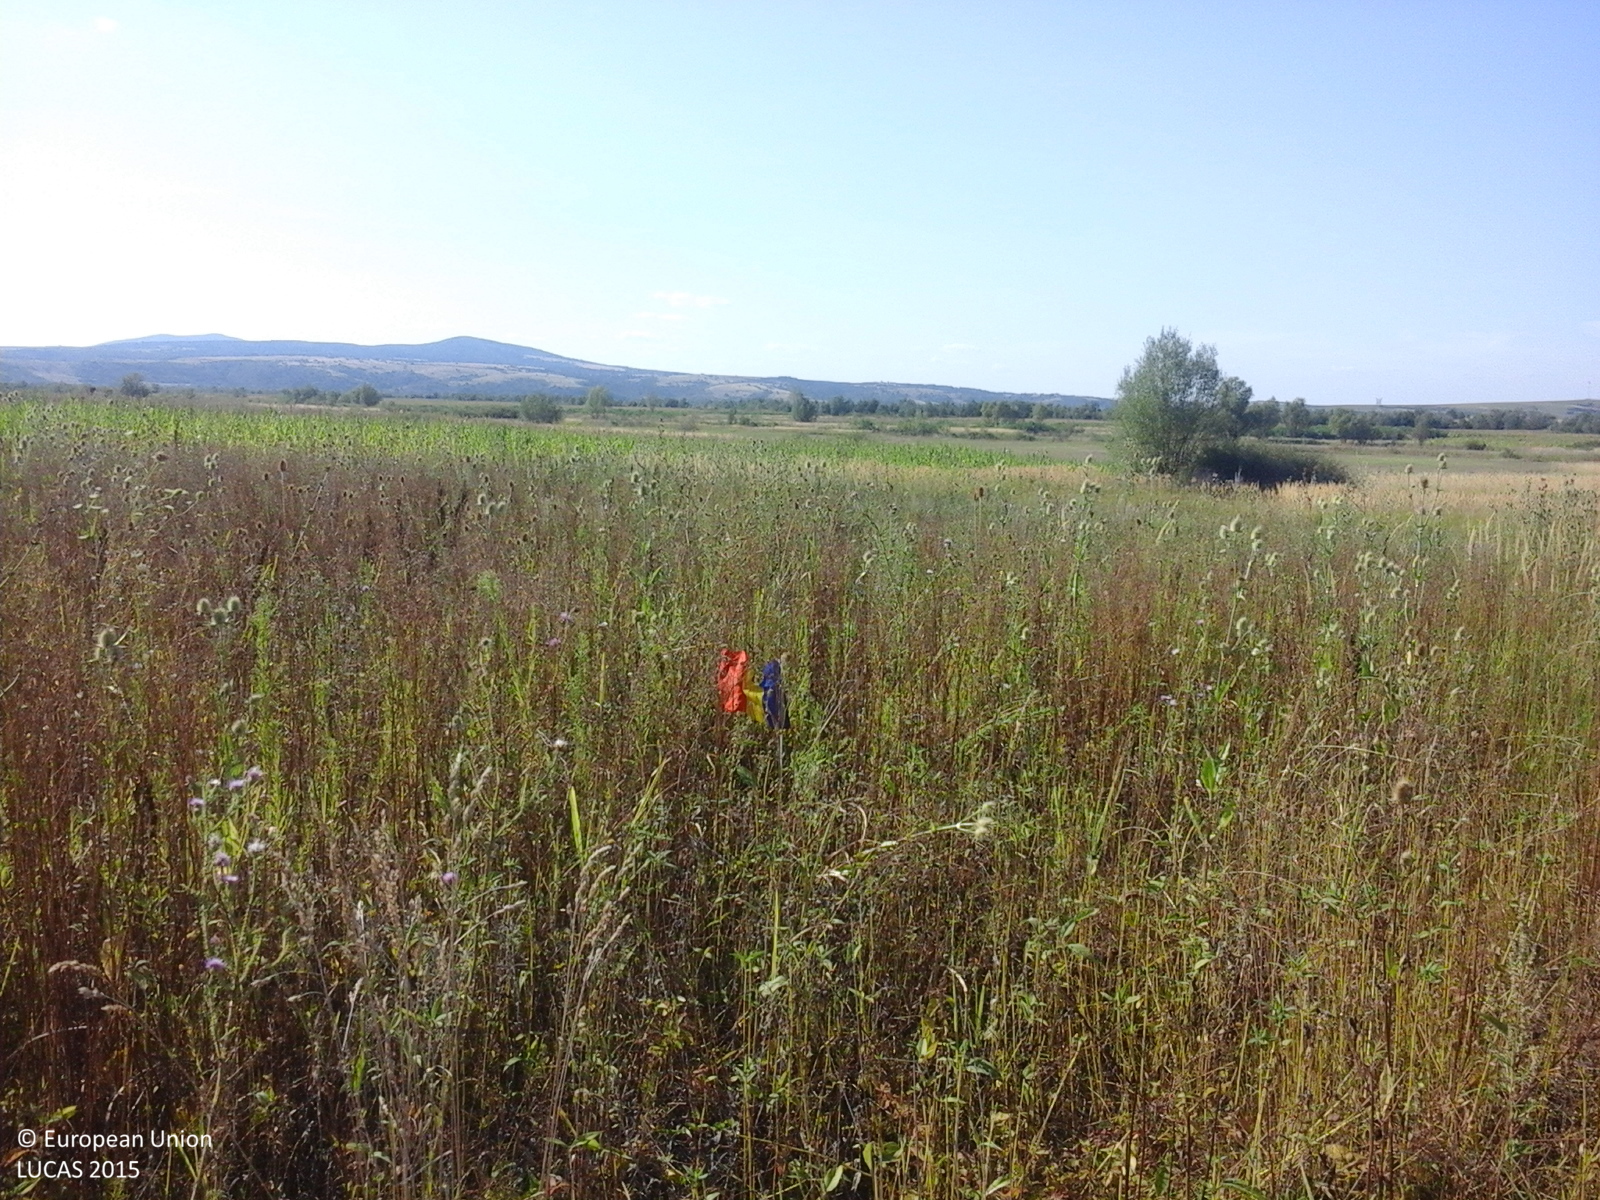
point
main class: Grassland
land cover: Spontaneously vegetated surfaces
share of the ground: > 75 %
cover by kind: herbaceous plants 100 %
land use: Fallow land
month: August
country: RO
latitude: 45.0806
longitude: 21.6040
